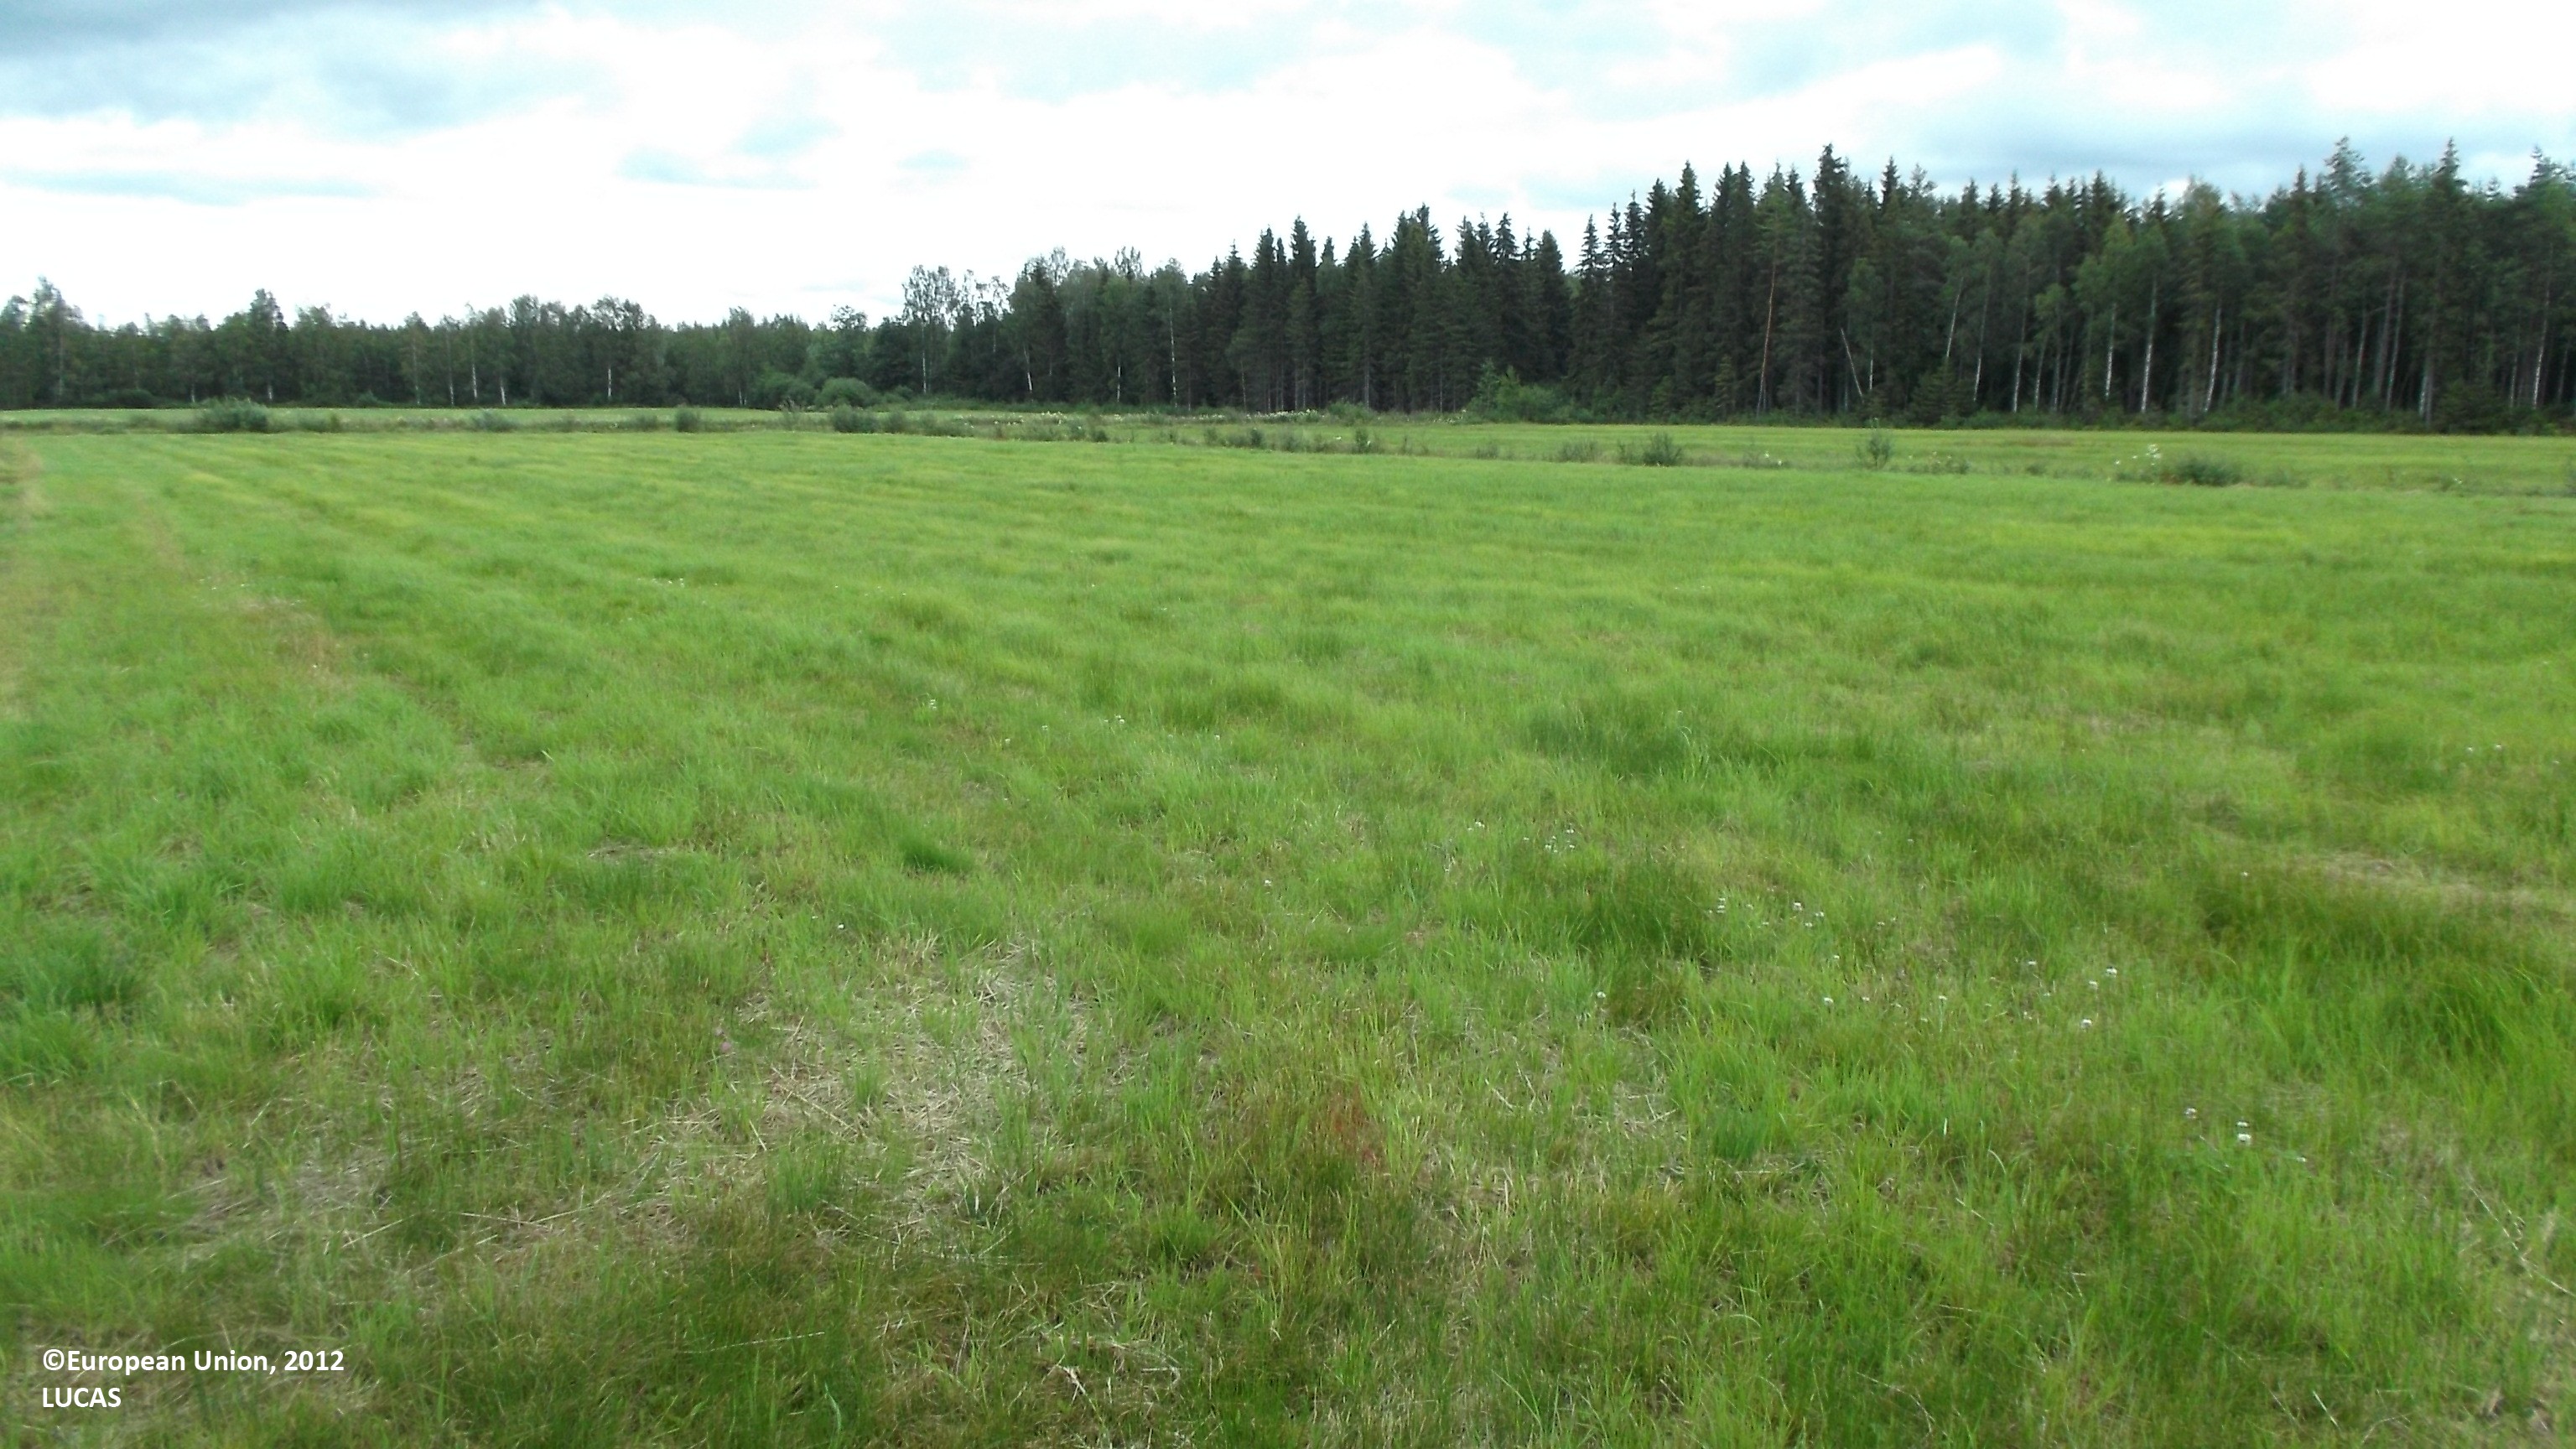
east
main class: Cropland
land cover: Temporary grasslands
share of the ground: > 75 %
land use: Agriculture (excluding fallow land and kitchen gardens)
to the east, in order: Temporary grasslands; Ditches and canals; Temporary grasslands; Ditches and canals; Abandoned hedges; Tracks; Spontaneously vegetated surfaces; Ditches and canals; Temporary grasslands; Ditches and canals; Abandoned hedges; Spruce dominated coniferous woodland; Spruce dominated mixed woodland
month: July
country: FI
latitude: 63.6774
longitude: 23.2145
